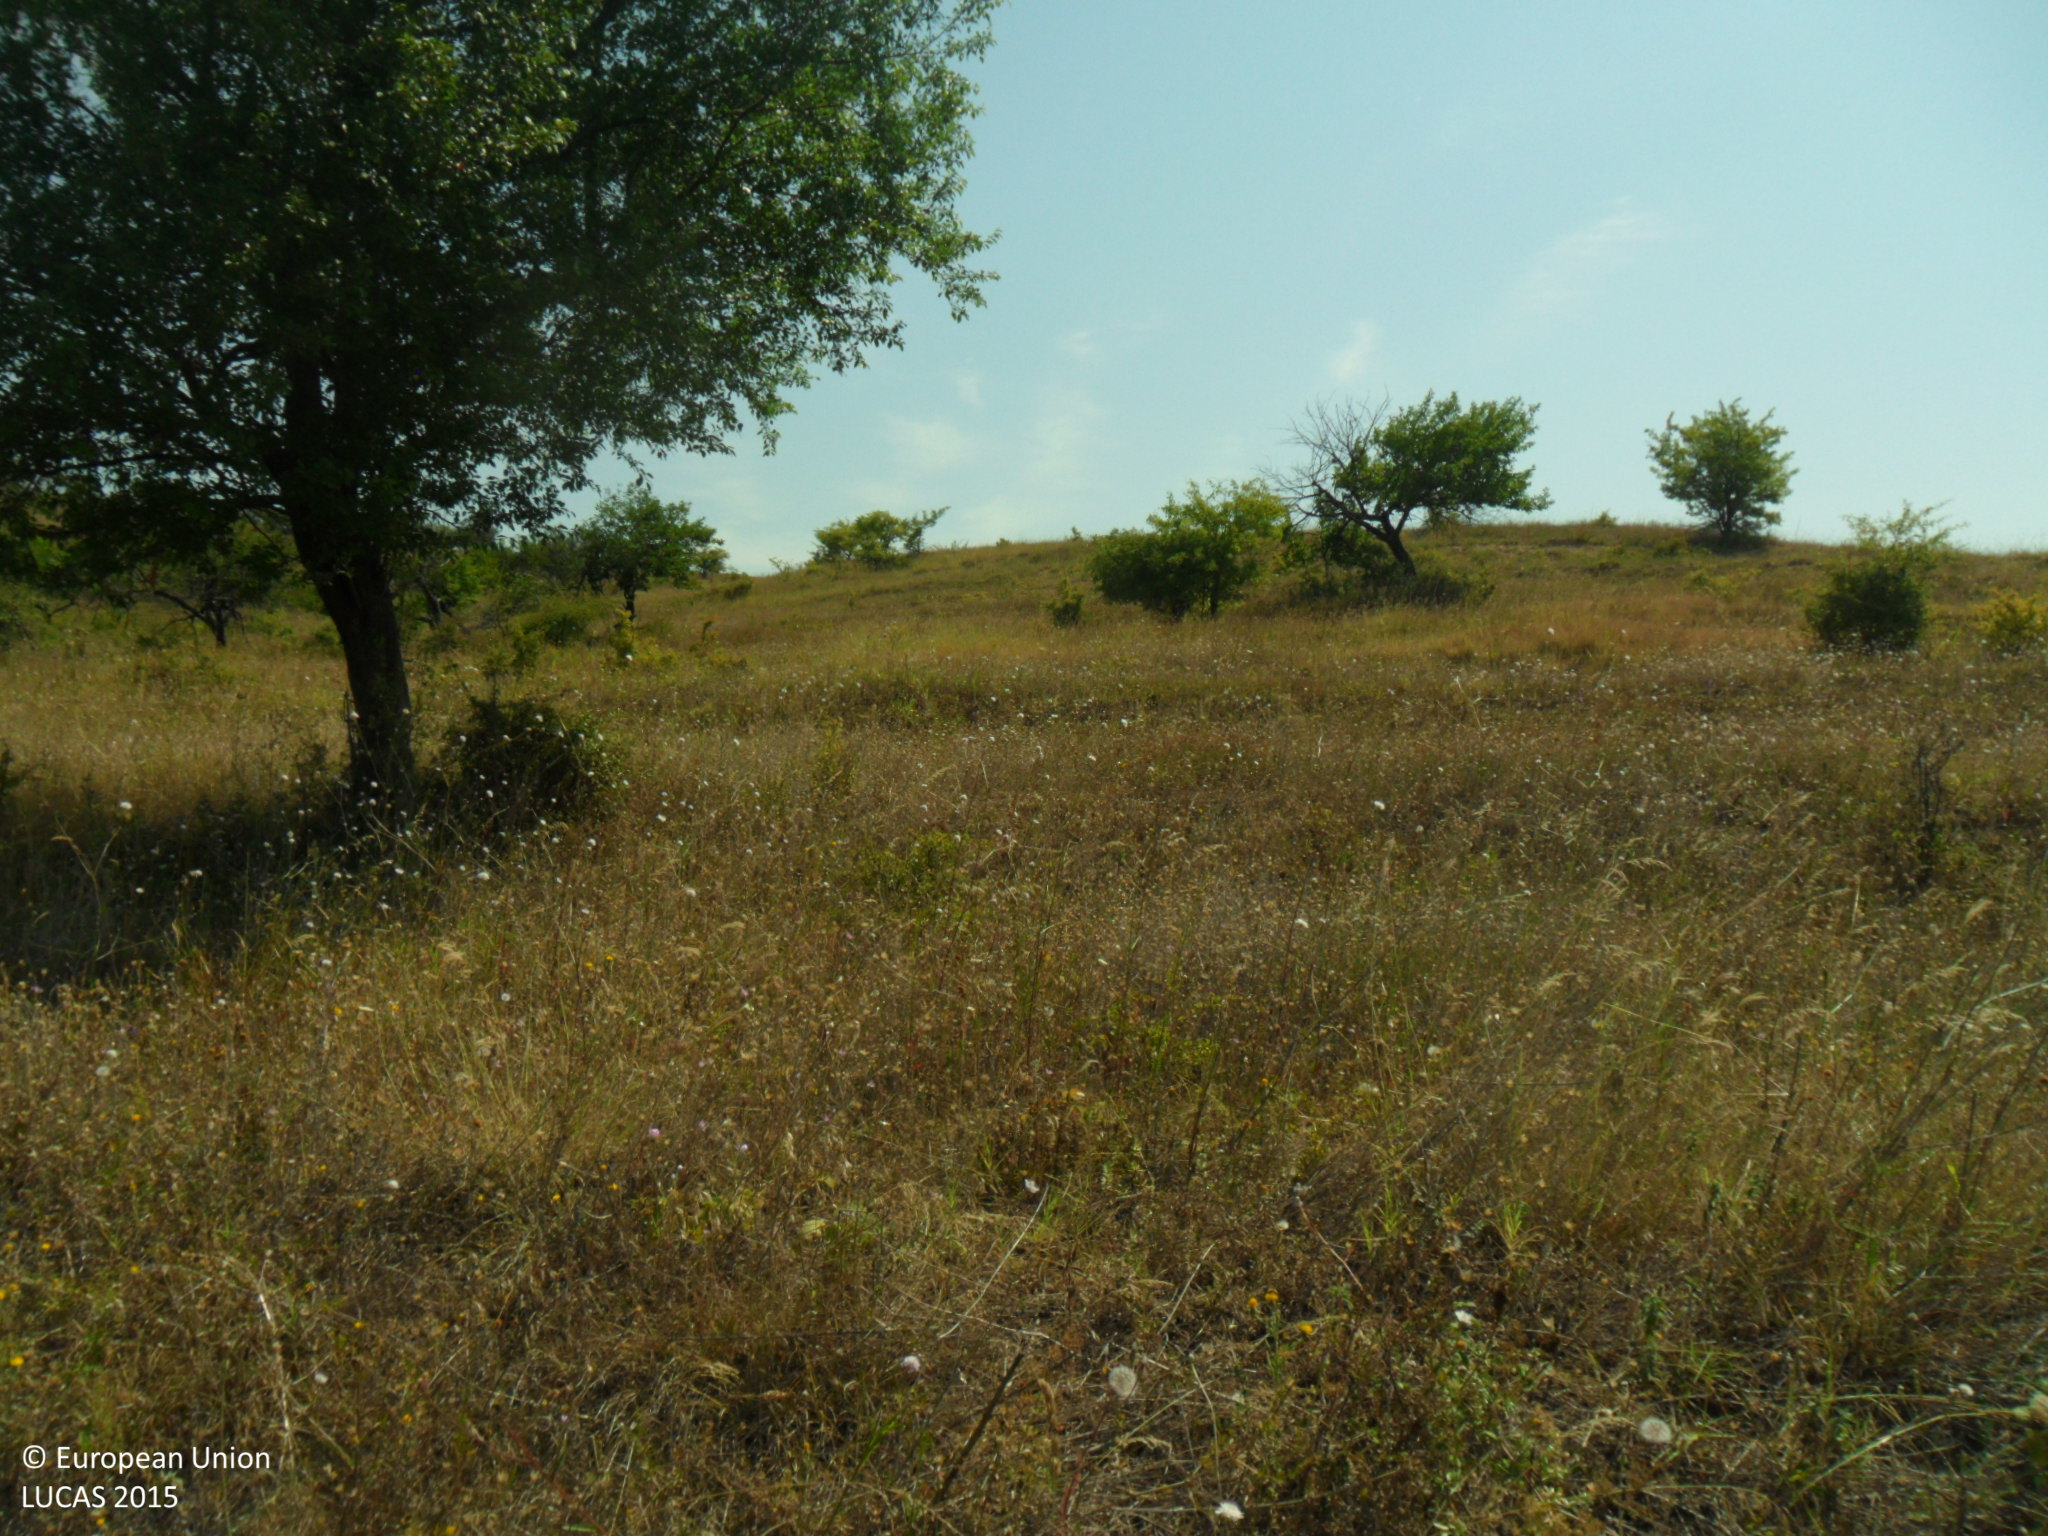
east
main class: Grassland
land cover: Grassland with sparse tree/shrub cover
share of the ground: > 75 %
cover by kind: herbaceous plants 90 %, broadleaved forest trees 5 %, shrubs 5 %
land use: Agriculture (excluding fallow land and kitchen gardens)
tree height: < 5 m
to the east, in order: Grassland with sparse tree/shrub cover; Other bare soil; Grassland with sparse tree/shrub cover; Tracks; Grassland with sparse tree/shrub cover; Ditches and canals; Grassland with sparse tree/shrub cover
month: August
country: BG
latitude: 43.4623
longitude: 26.7086
